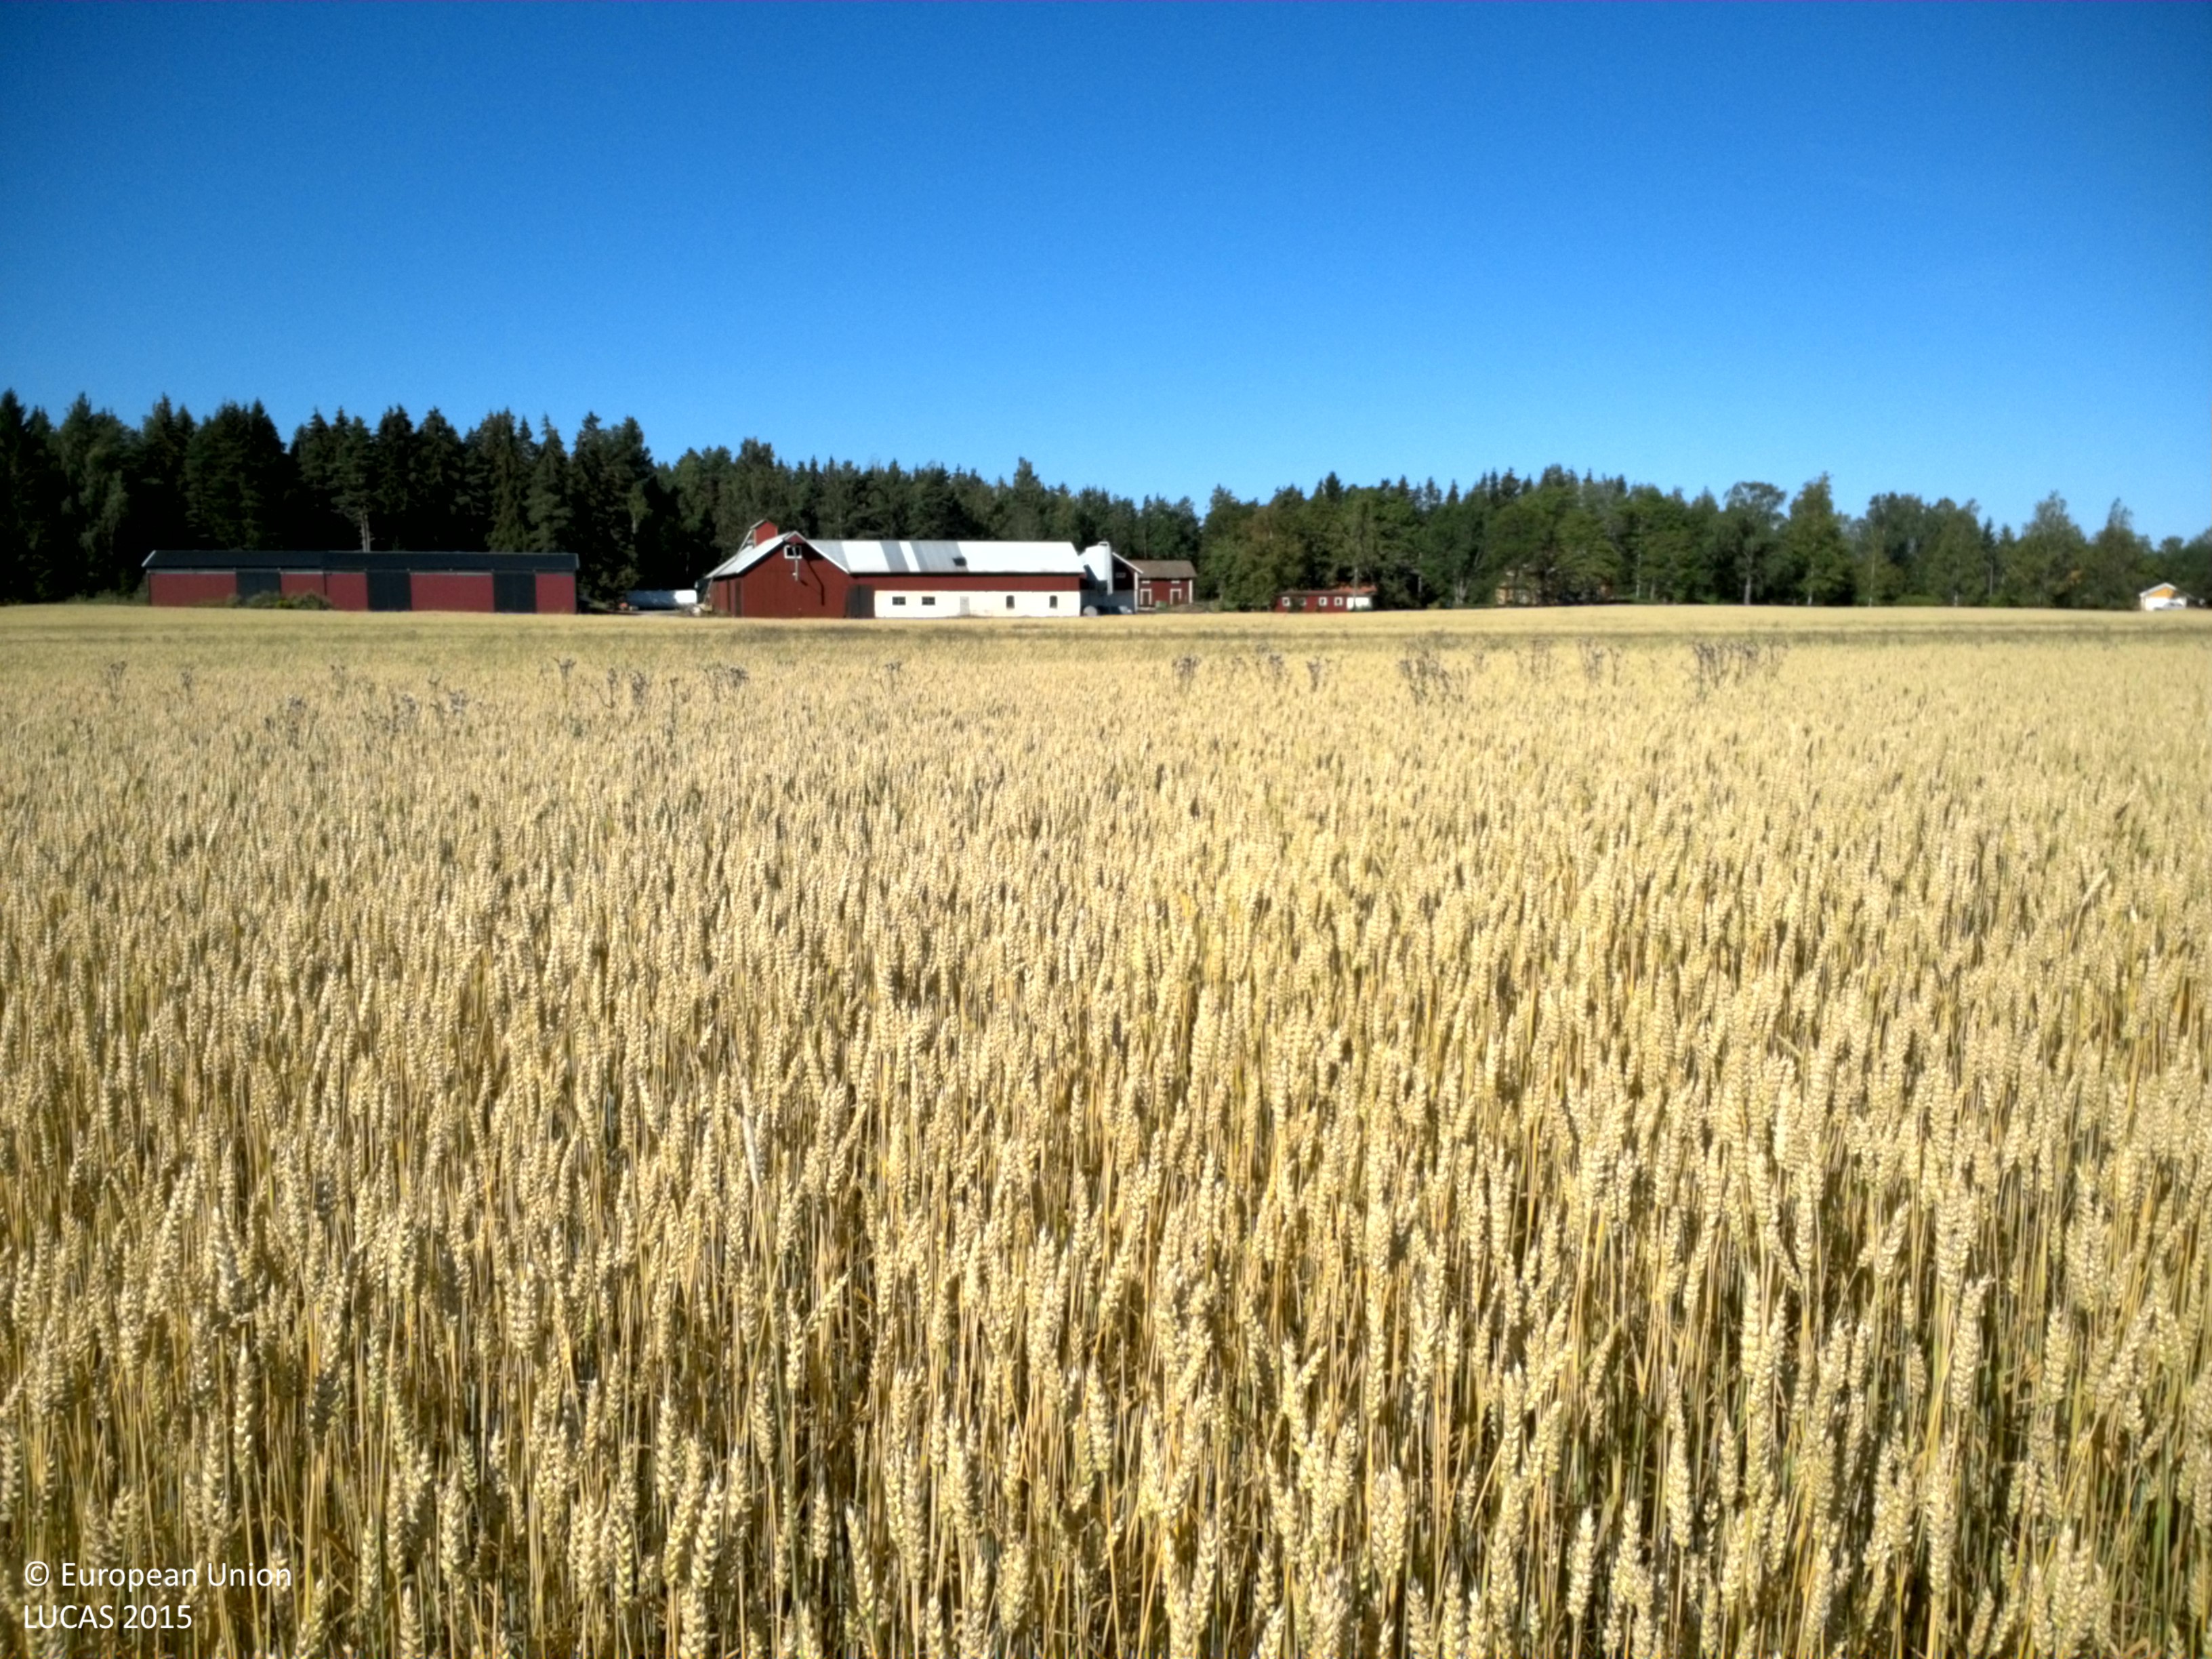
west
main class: Cropland
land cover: Common wheat
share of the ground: > 75 %
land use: Agriculture (excluding fallow land and kitchen gardens)
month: August
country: SE
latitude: 59.8969
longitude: 16.6585
